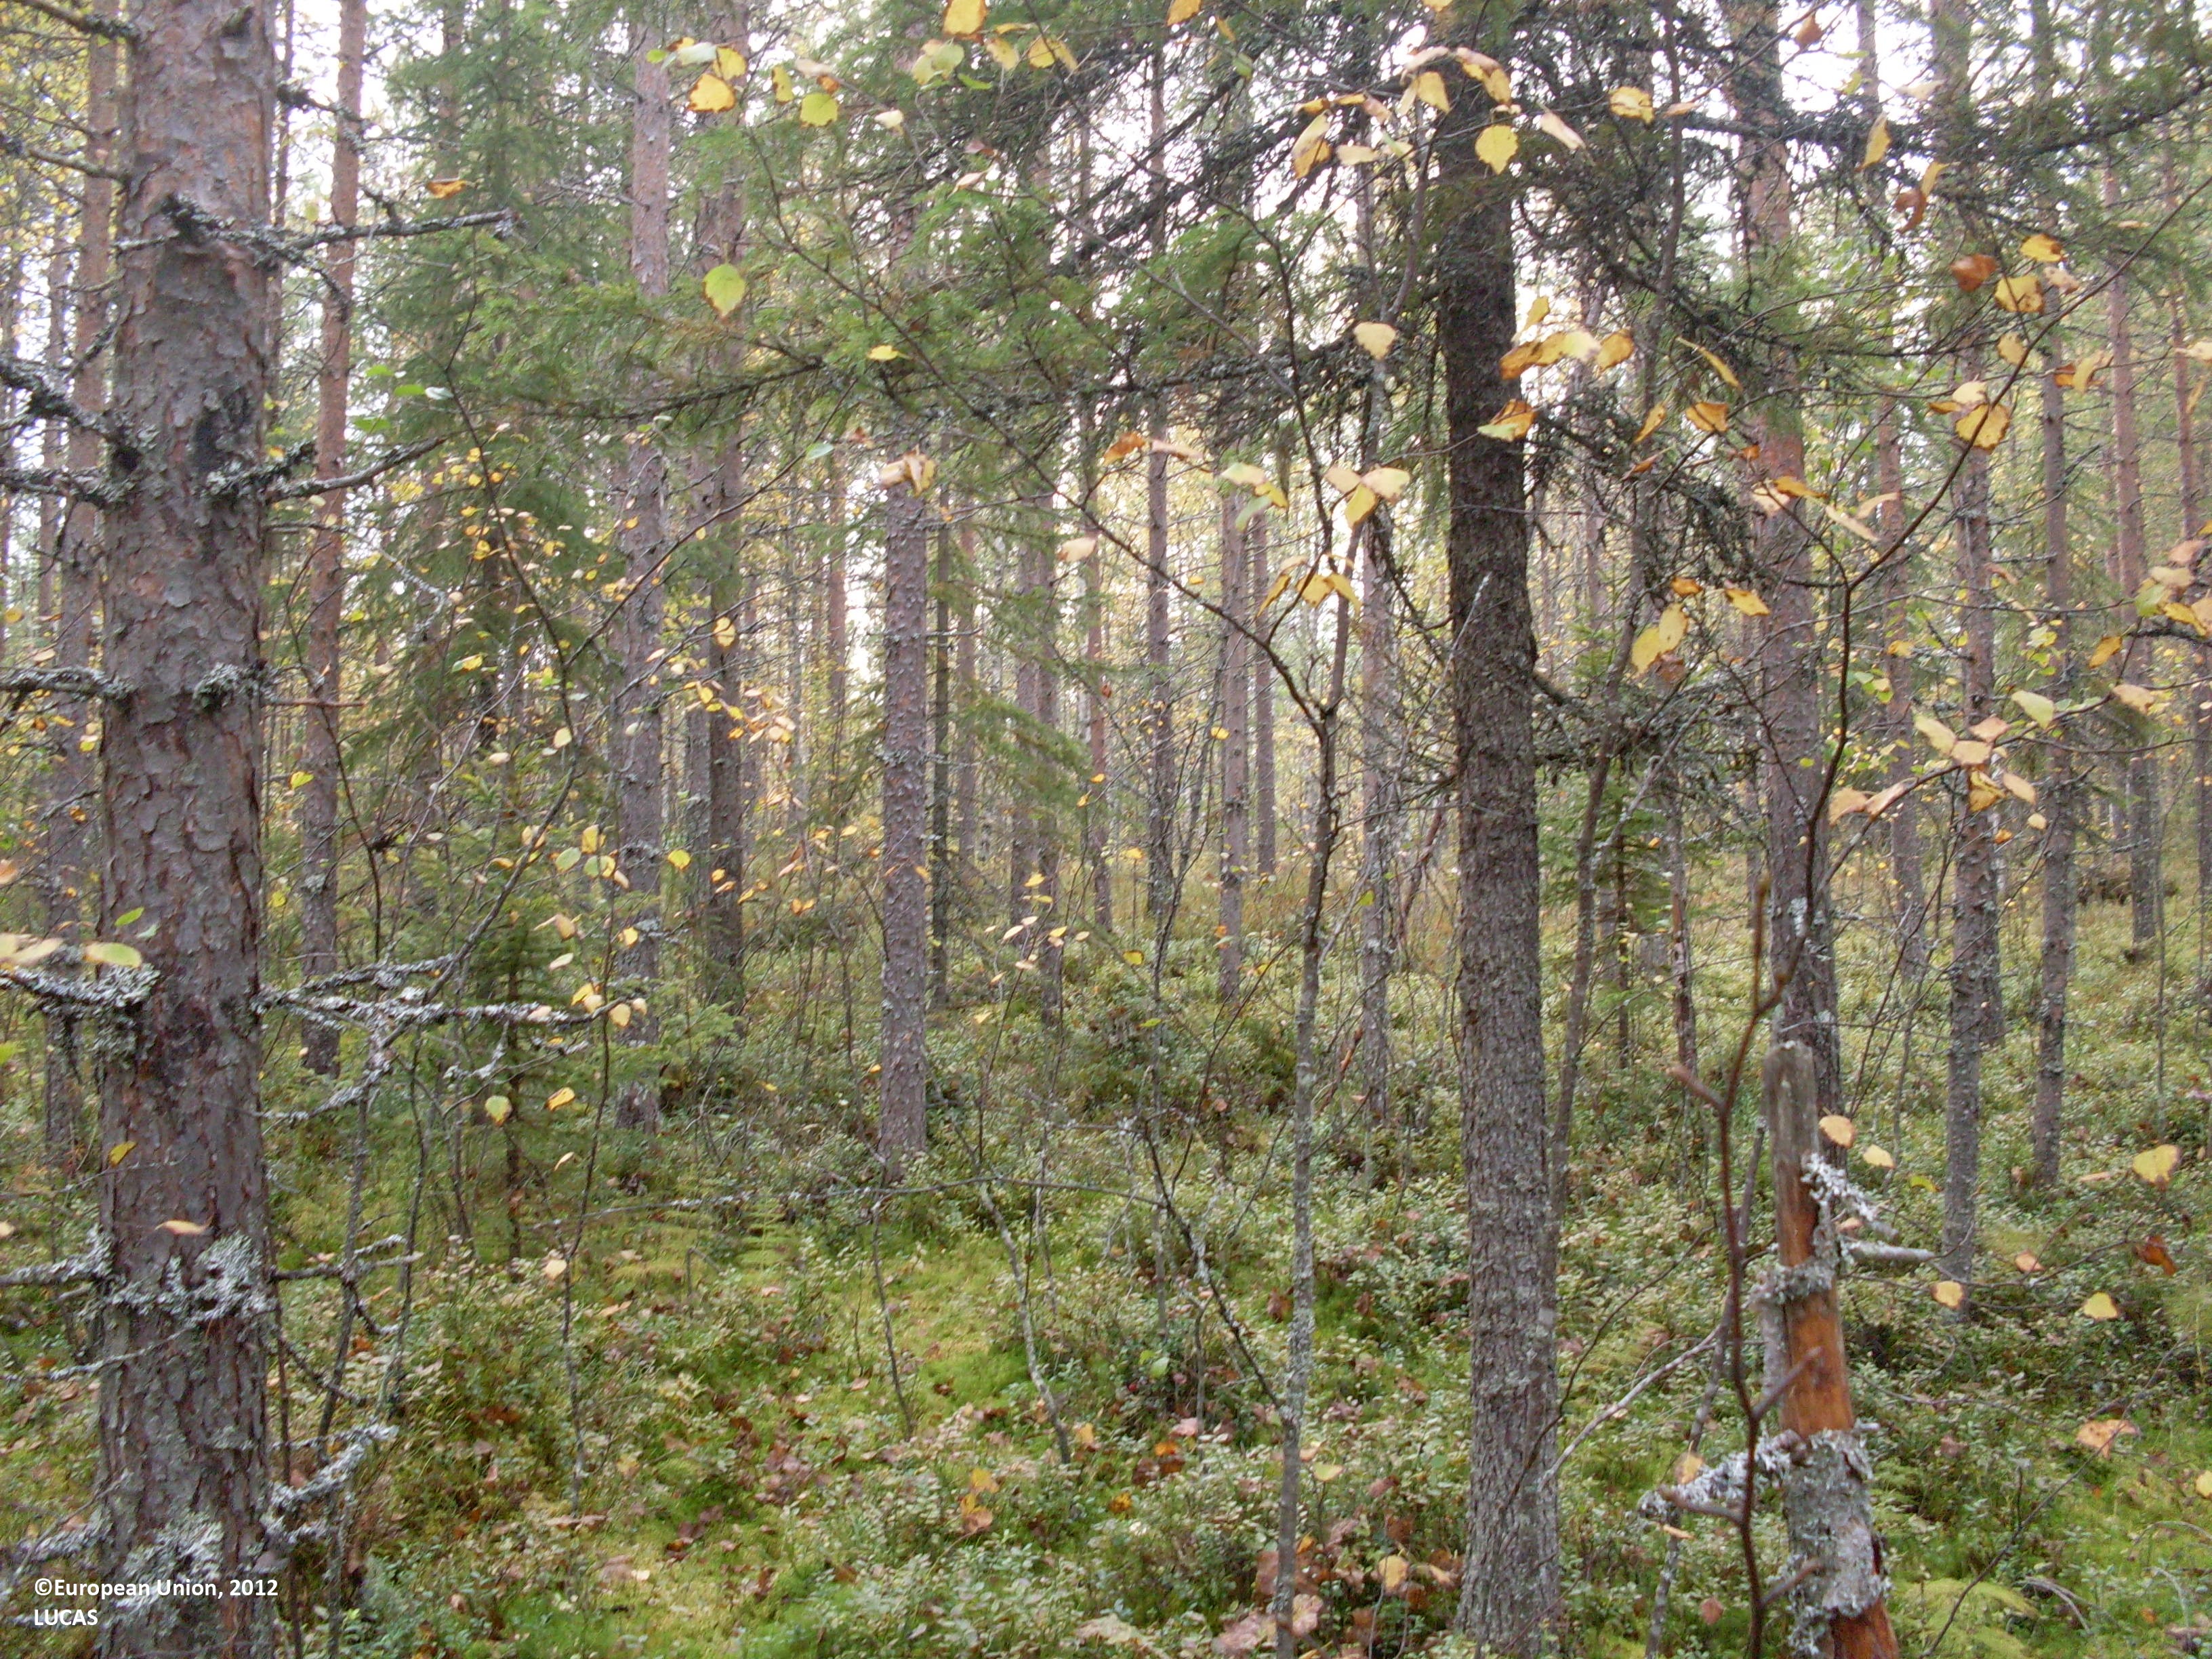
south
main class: Woodland
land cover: Pine dominated coniferous woodland
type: boreal forest
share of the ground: > 75 %
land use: Forestry
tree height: > 5 m
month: September
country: FI
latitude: 64.2655
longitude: 30.2931
